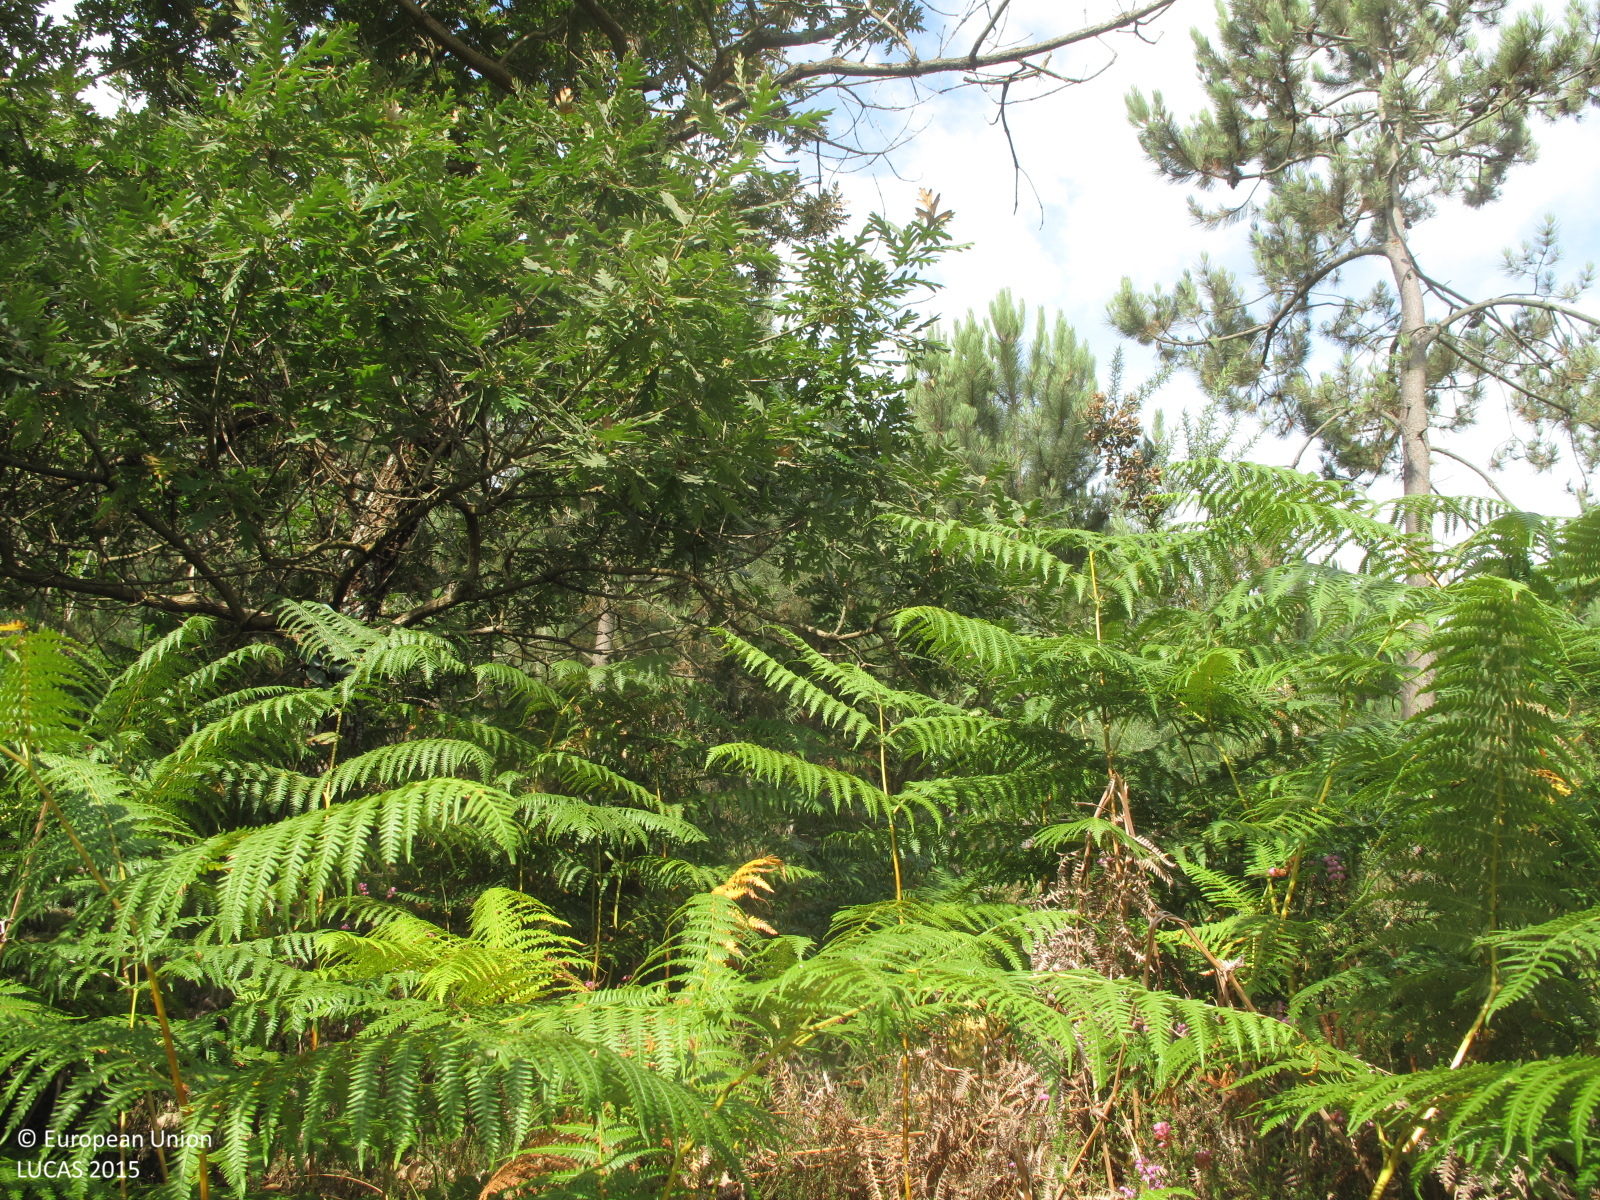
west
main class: Woodland
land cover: Other mixed woodland
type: exotic forest
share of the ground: 25 - 50 %
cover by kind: broadleaved forest trees 30 %, shrubs 30 %, coniferous forest trees 20 %, herbaceous plants 20 %
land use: Forestry
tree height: > 5 m
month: July
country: ES
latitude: 43.3035
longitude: -8.5655
